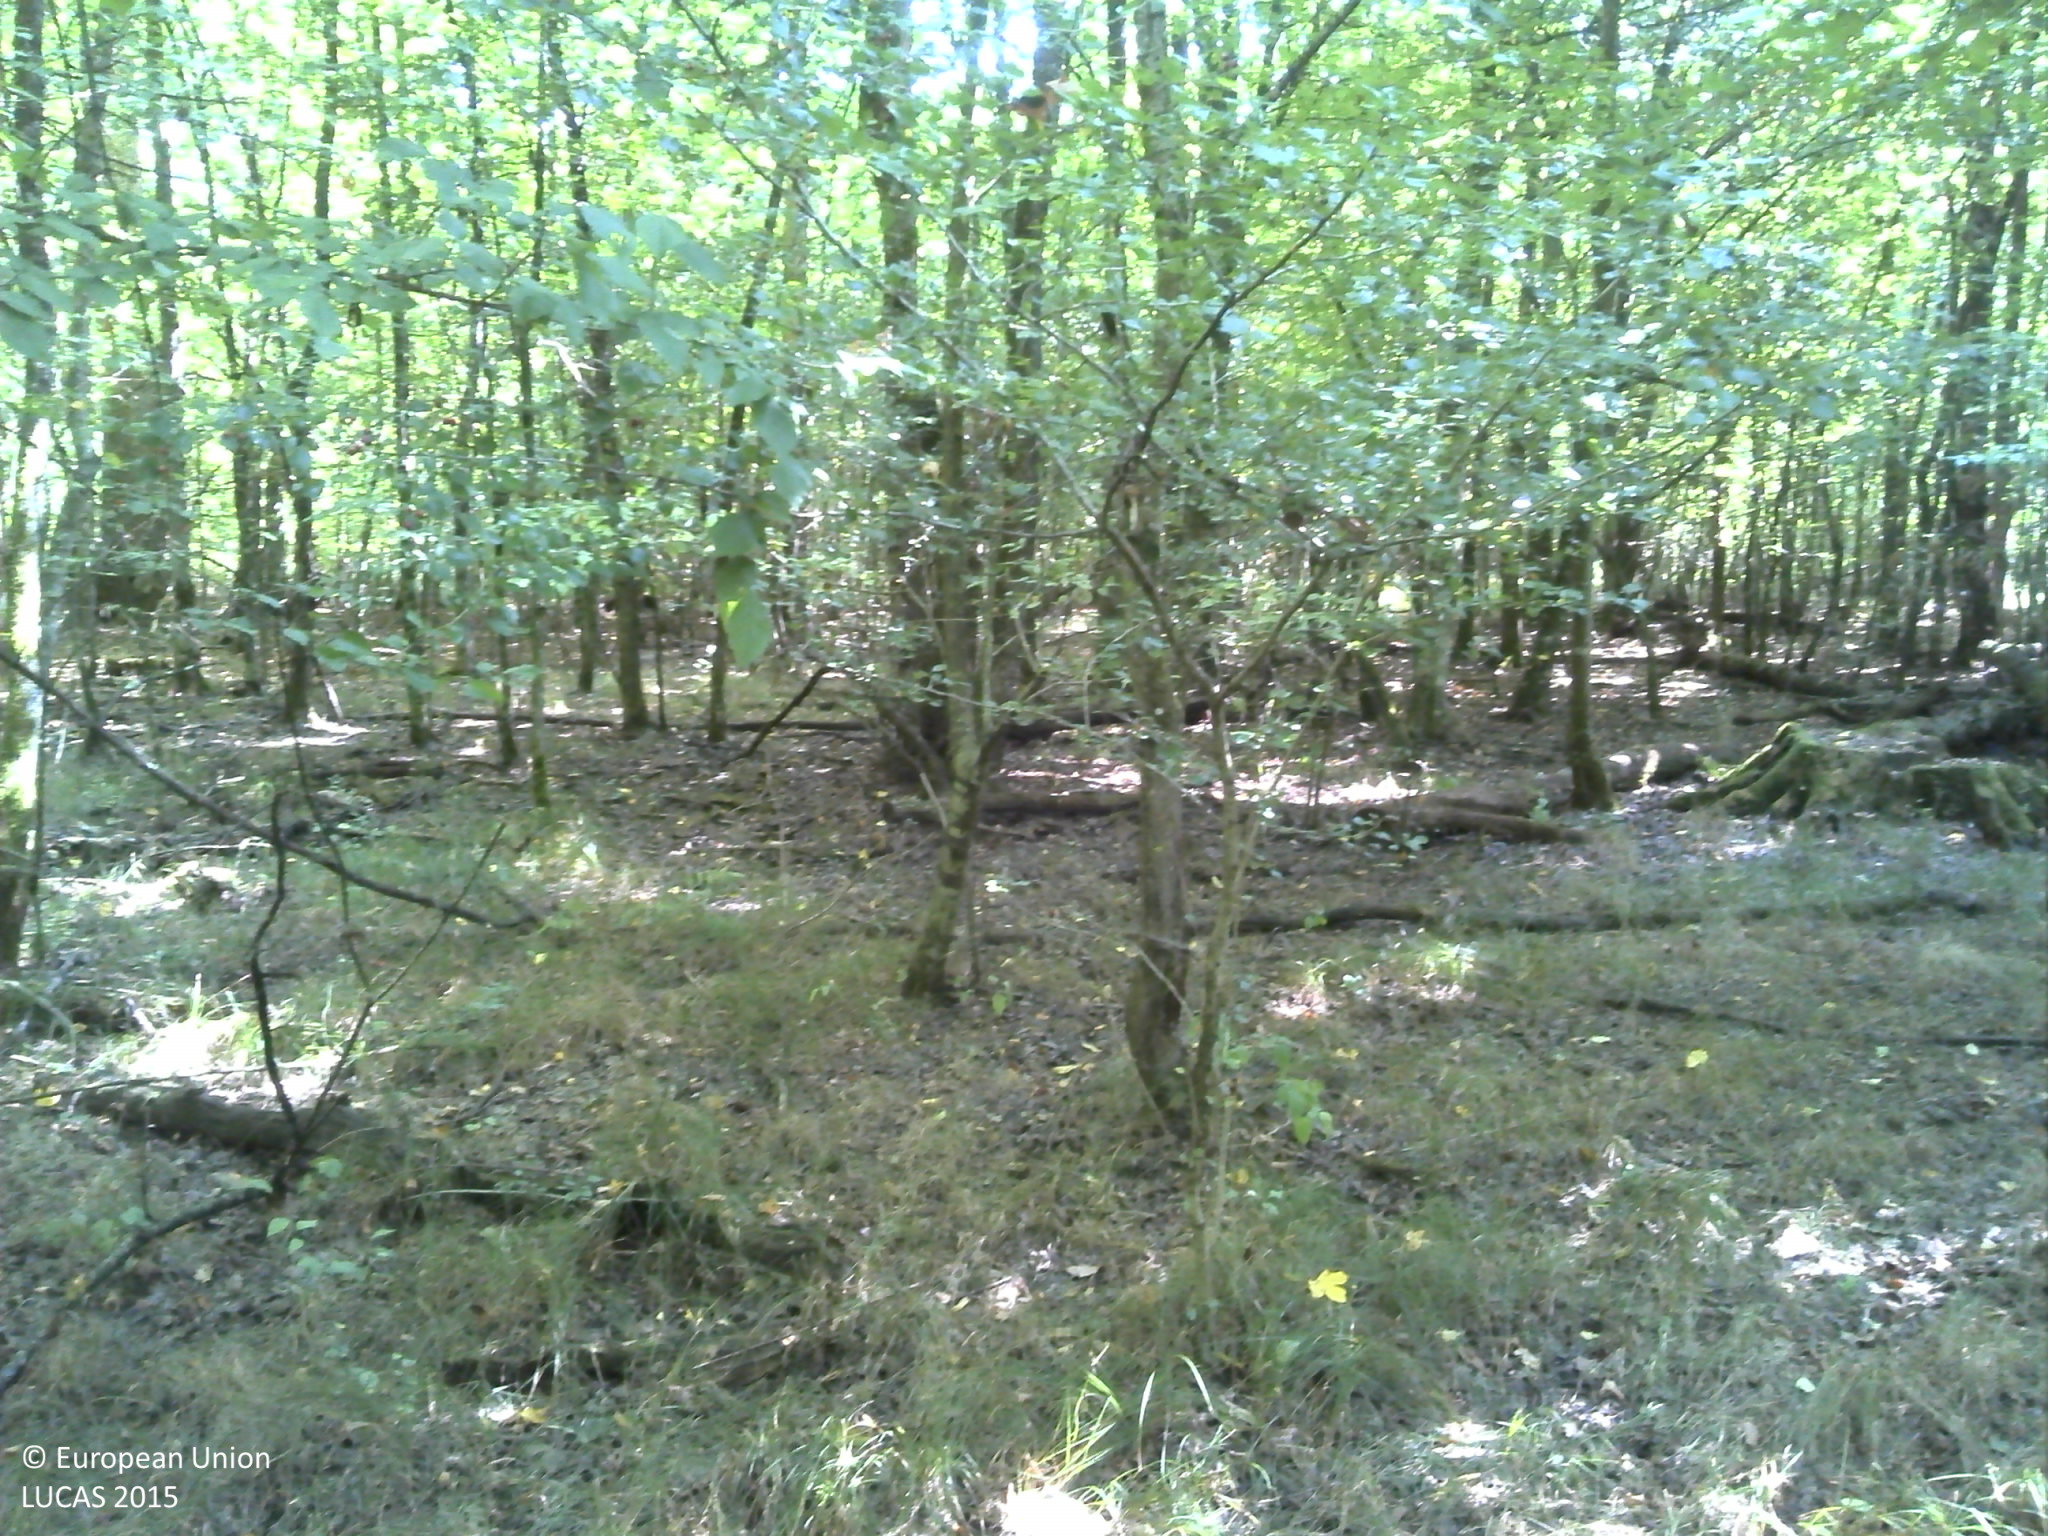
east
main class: Woodland
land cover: Broadleaved woodland
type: mesophytic deciduous forest
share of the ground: > 75 %
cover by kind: broadleaved forest trees 100 %
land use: Forestry
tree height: > 5 m
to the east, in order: Broadleaved woodland
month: September
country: HR
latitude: 45.6784
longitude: 16.5850
